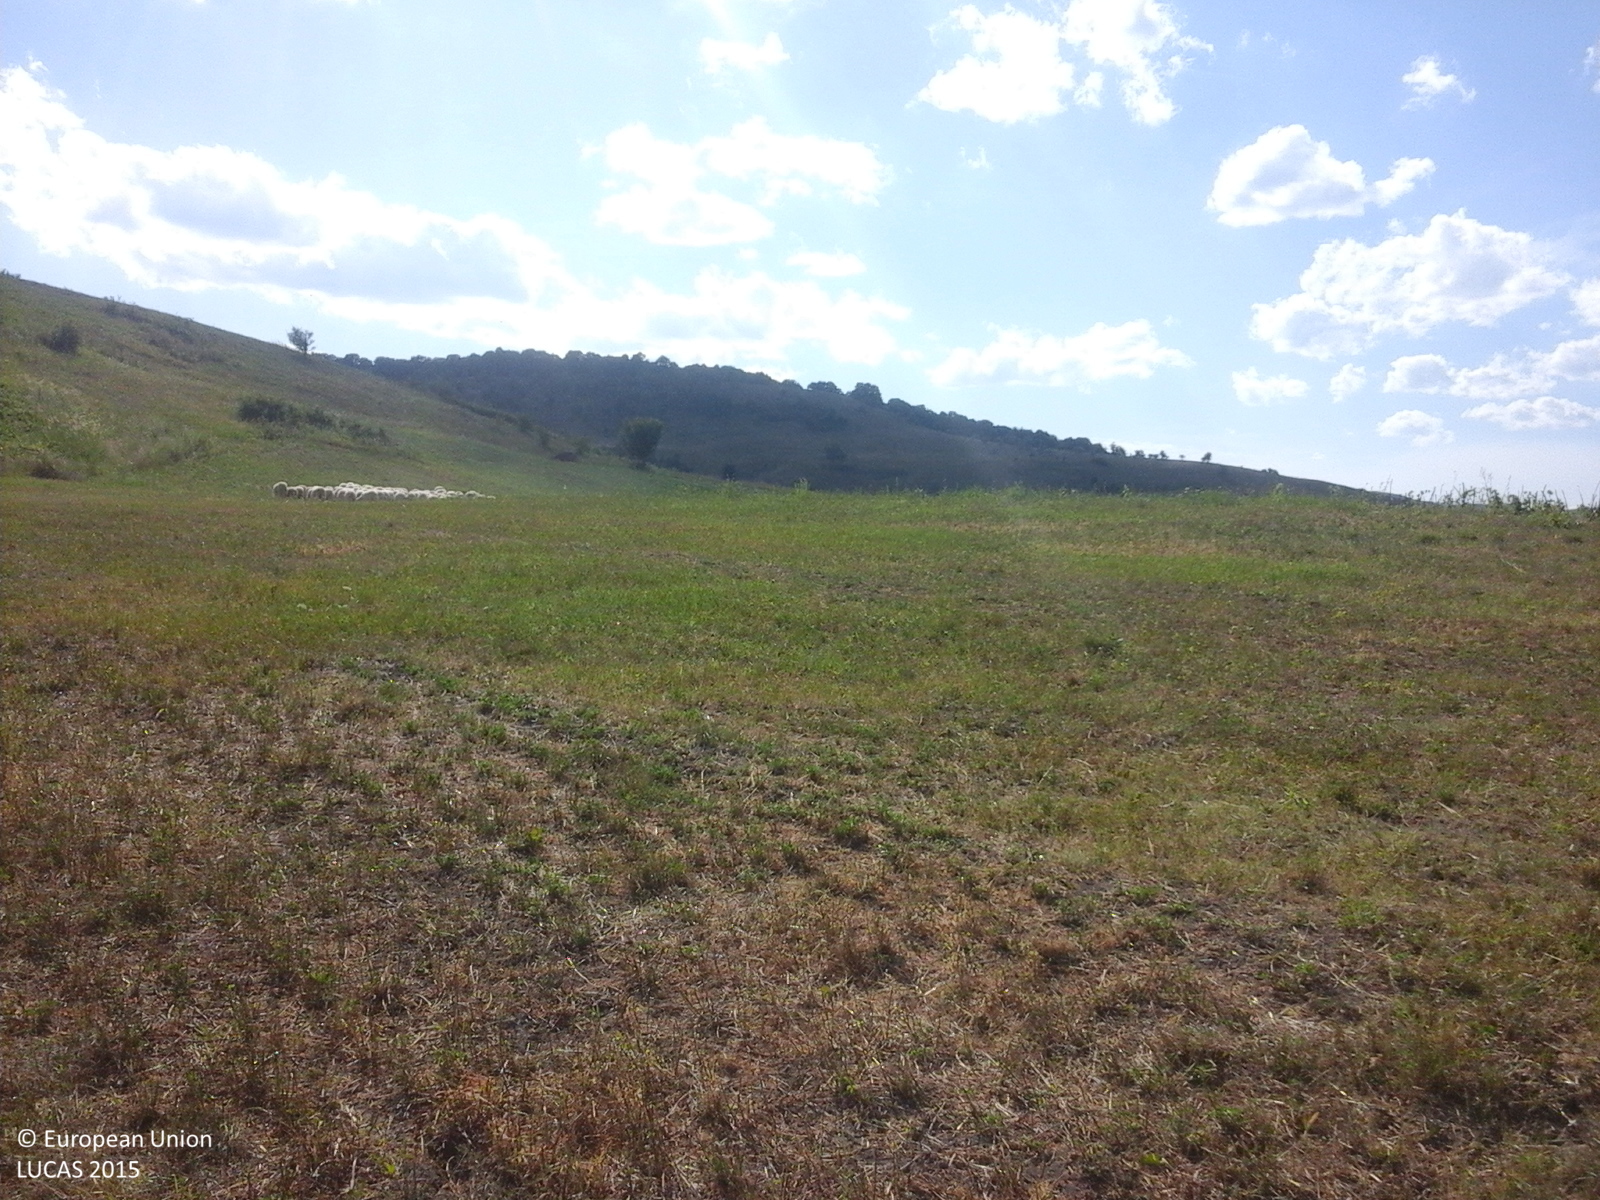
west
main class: Cropland
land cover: Lucerne
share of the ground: > 75 %
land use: Agriculture (excluding fallow land and kitchen gardens)
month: July
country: RO
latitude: 46.5943
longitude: 27.3497
